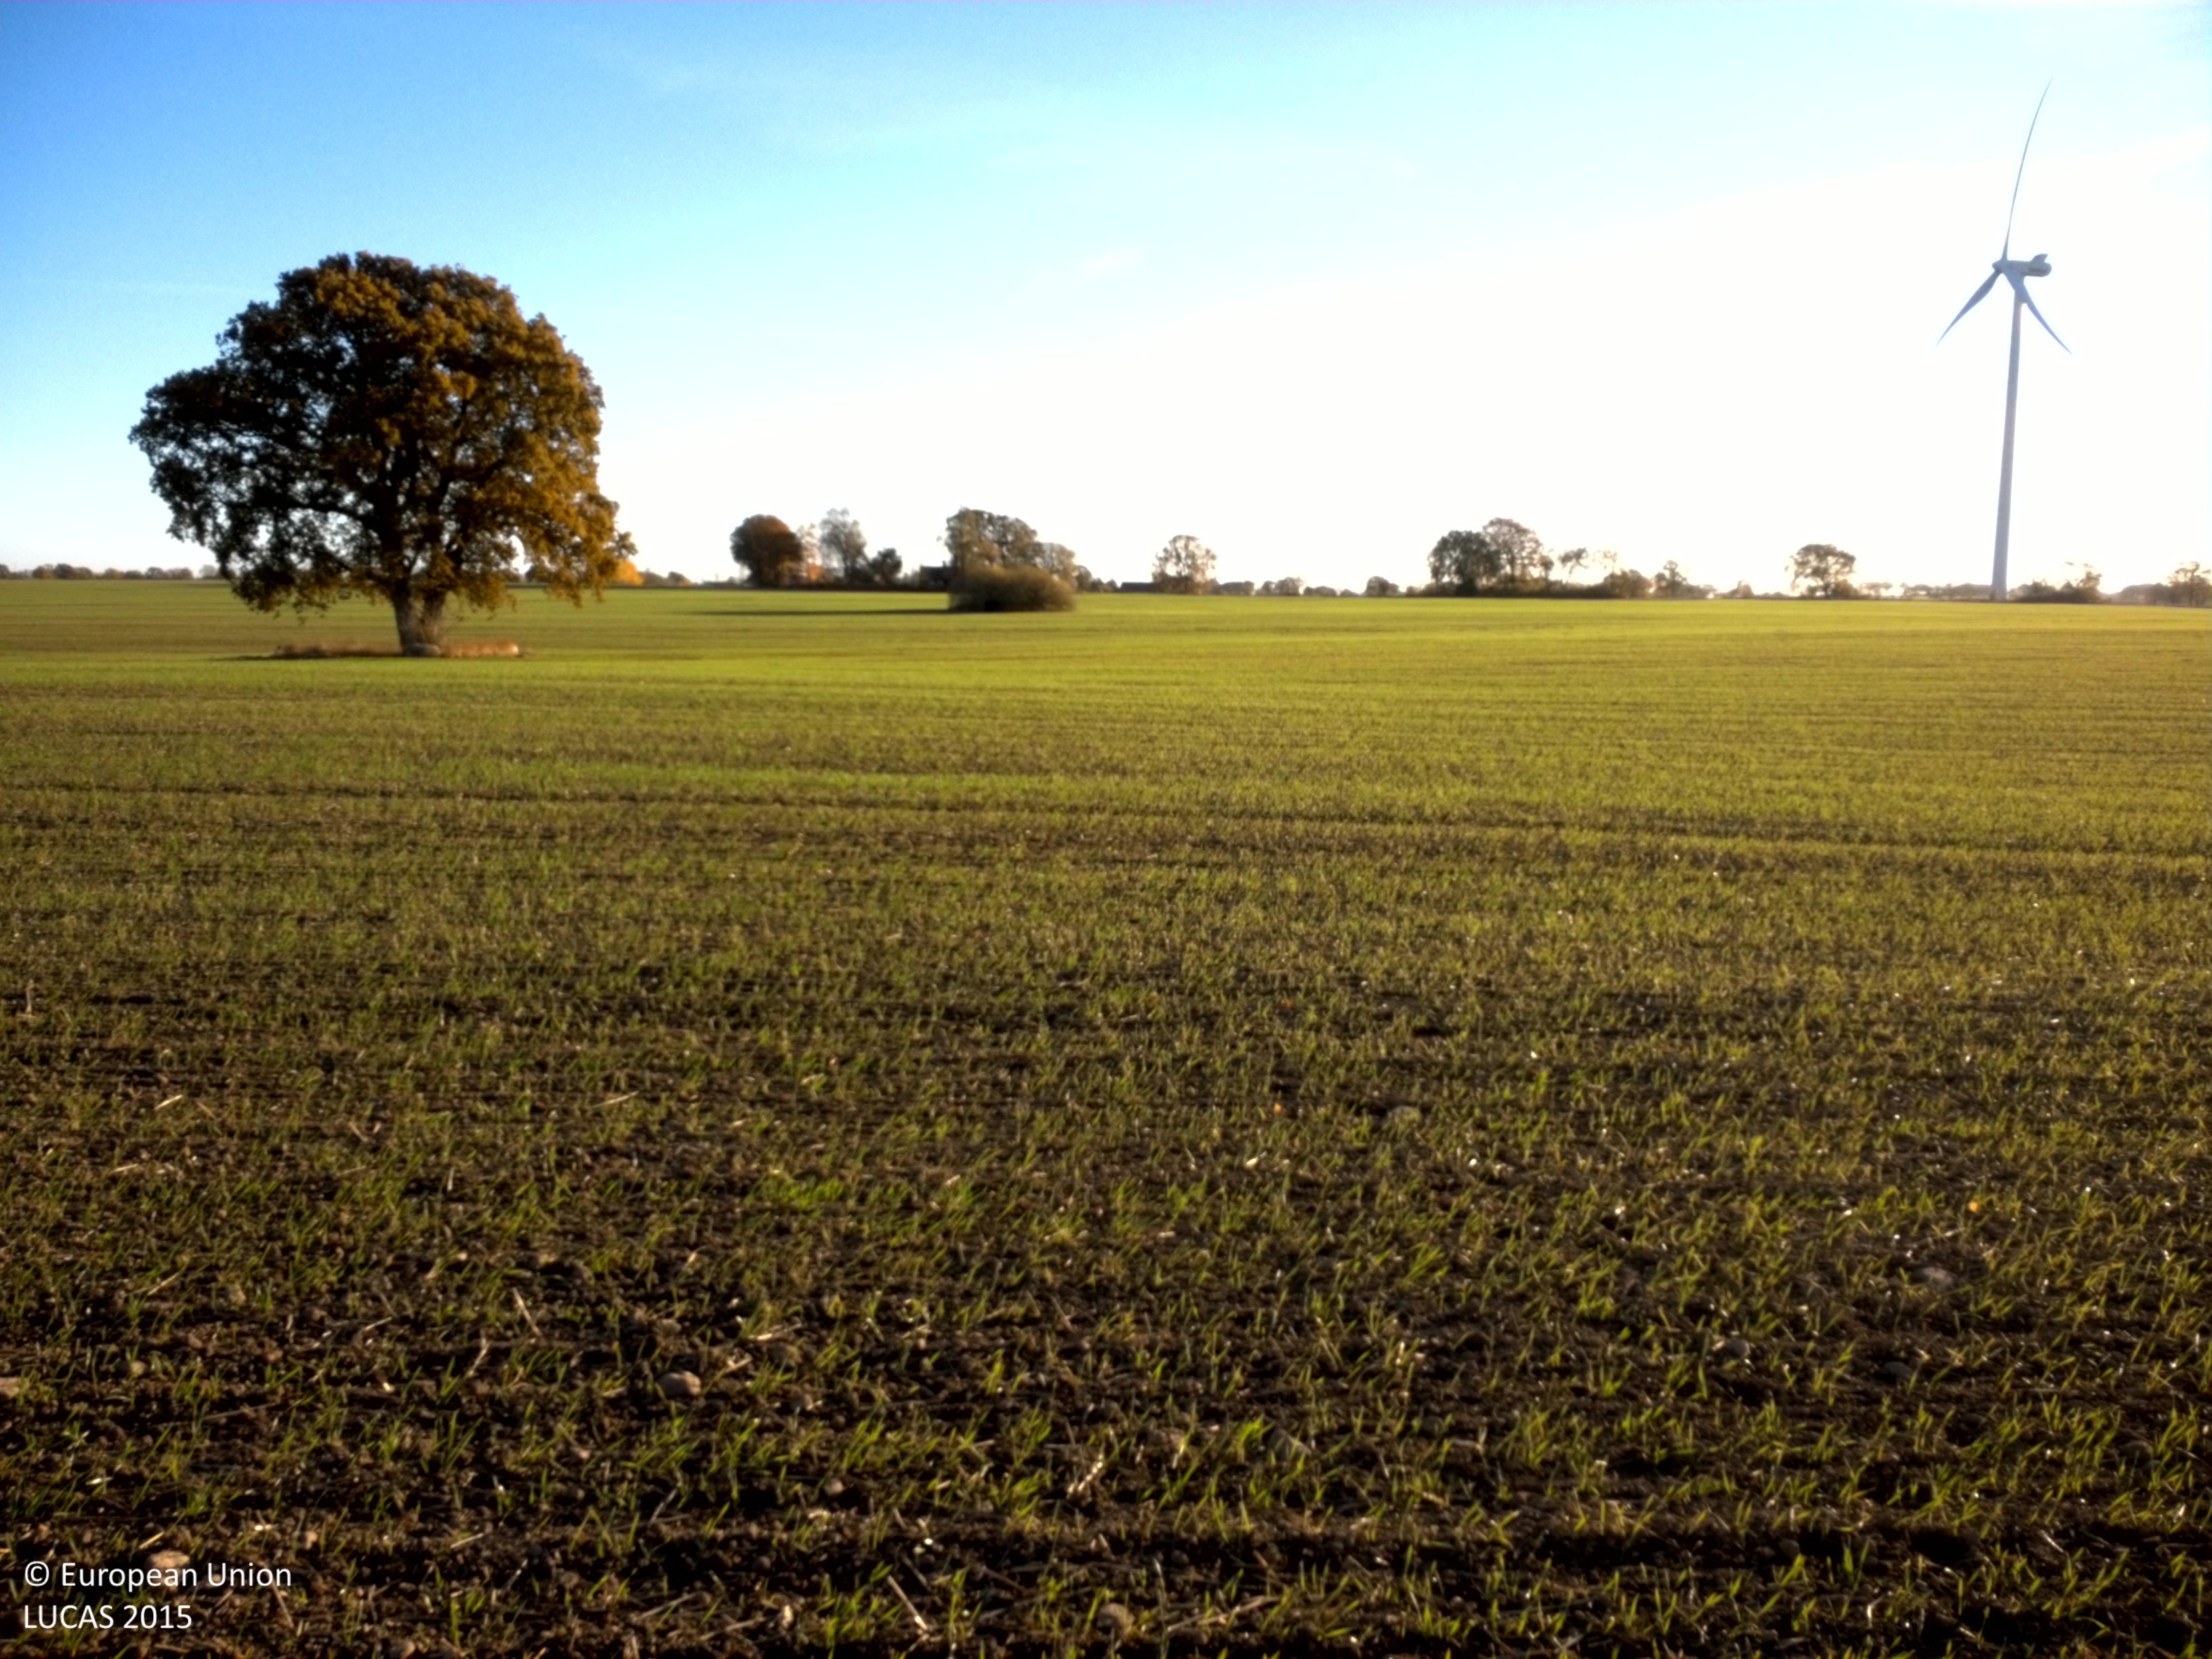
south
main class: Cropland
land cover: Common wheat
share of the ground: < 10 %
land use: Agriculture (excluding fallow land and kitchen gardens)
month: October
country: SE
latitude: 55.9535
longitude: 13.0566
